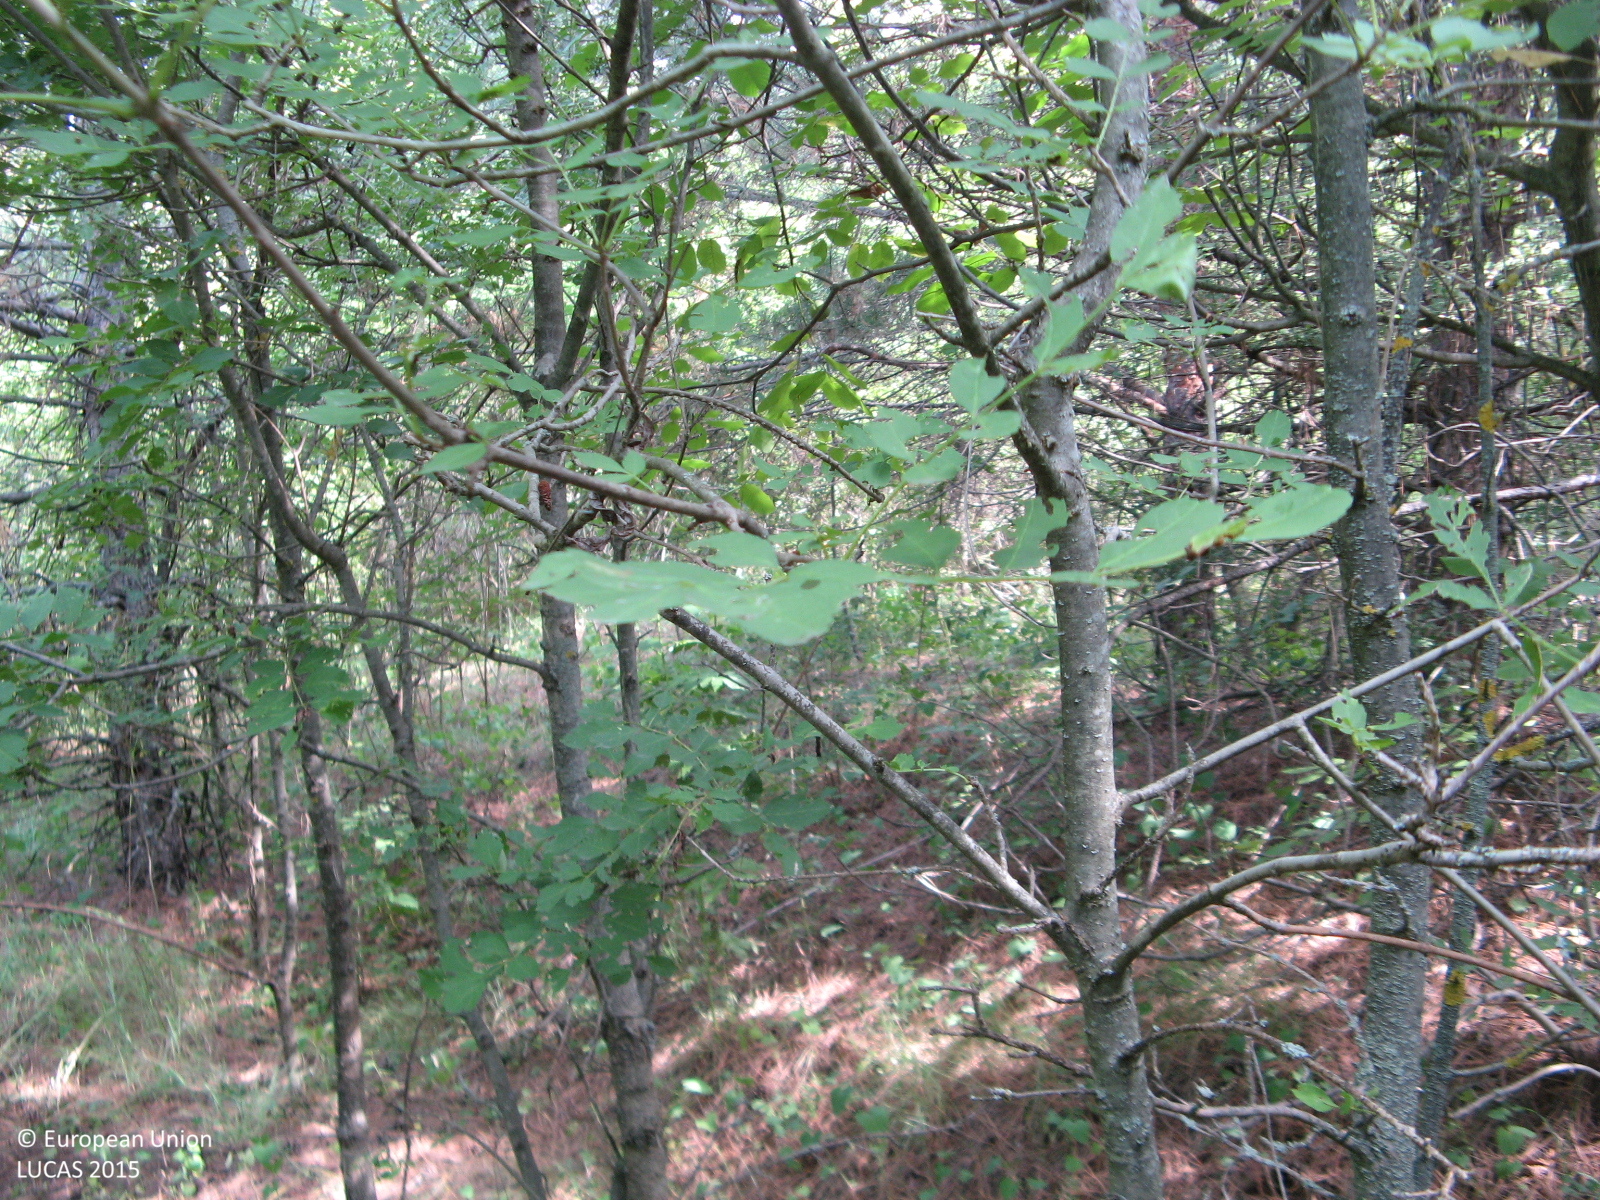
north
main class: Woodland
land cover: Pine dominated mixed woodland
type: hemiboreal forest and nemoral coniferous forest and mixed broadleaved-coniferous forest
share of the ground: 50 - 75 %
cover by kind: coniferous forest trees 60 %, broadleaved forest trees 25 %, herbaceous plants 10 %, shrubs 5 %
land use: Forestry
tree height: > 5 m
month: August
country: BG
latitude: 43.6238
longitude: 25.8164
